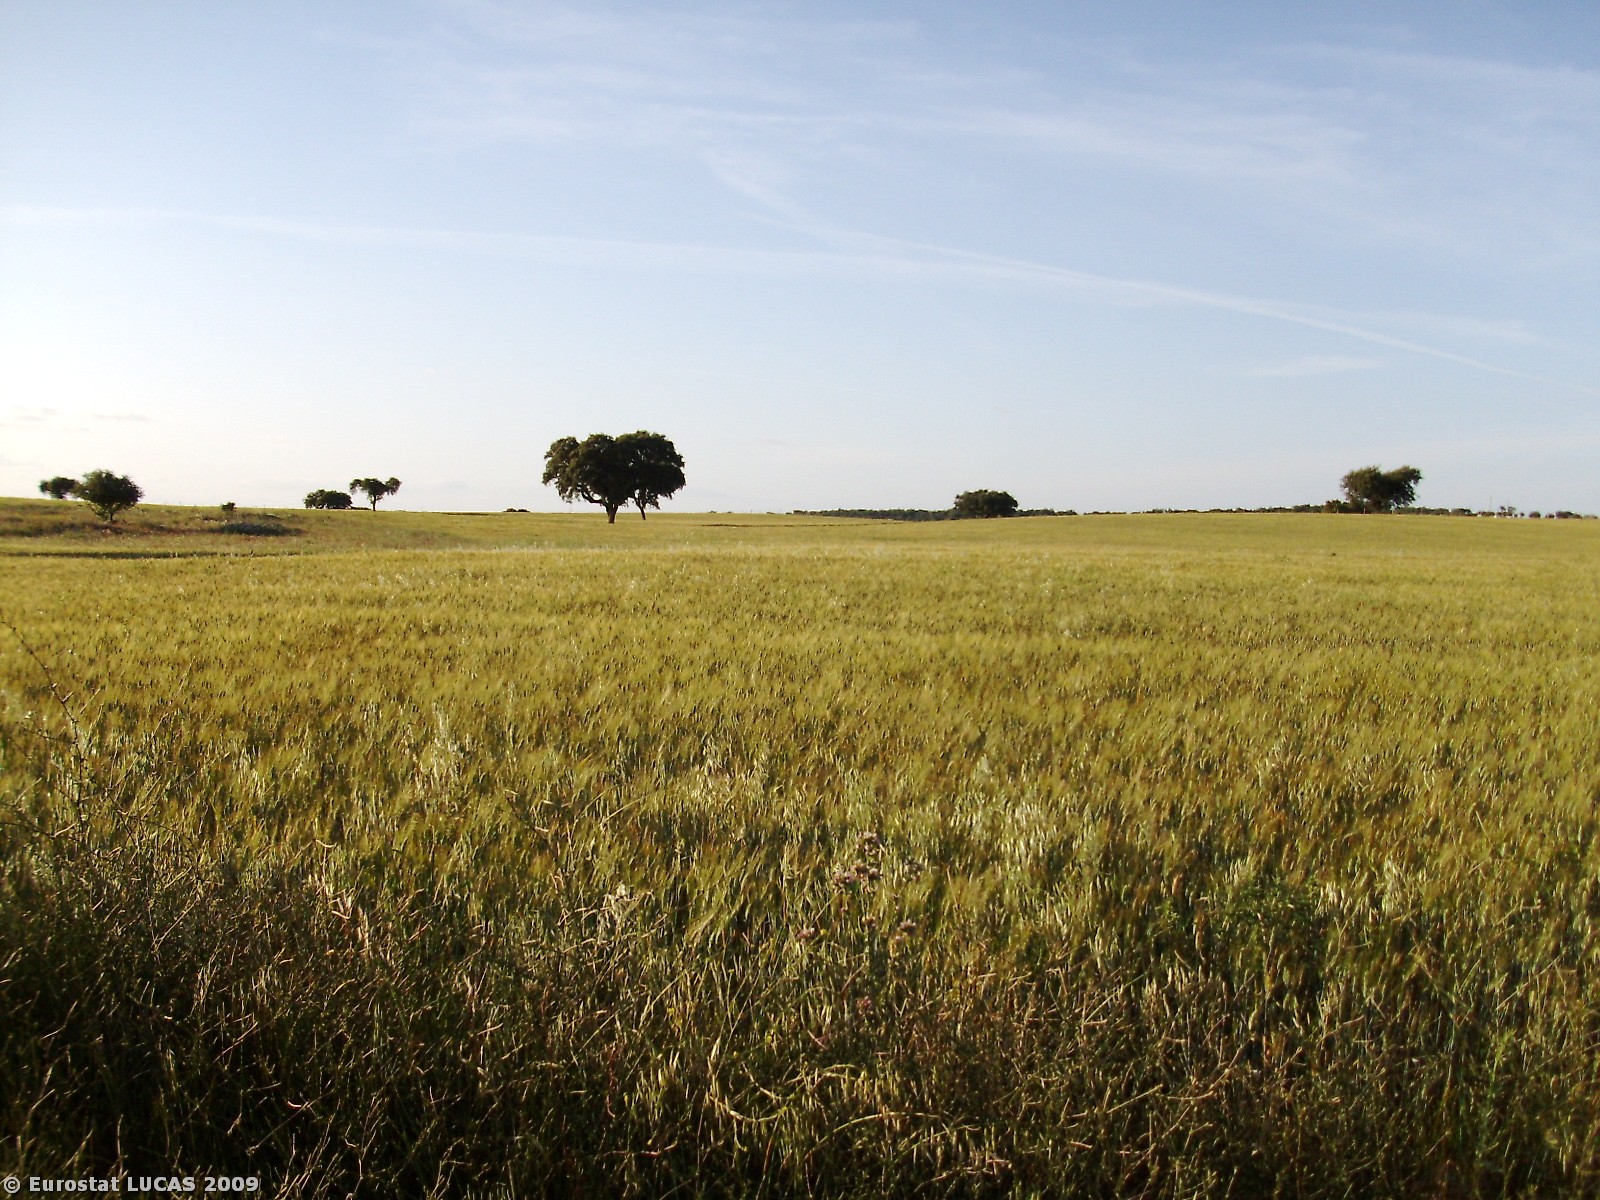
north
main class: Cropland
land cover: Durum wheat
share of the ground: > 75 %
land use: Agriculture (excluding fallow land and kitchen gardens)
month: May
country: PT
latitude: 39.0360
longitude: -7.8730
